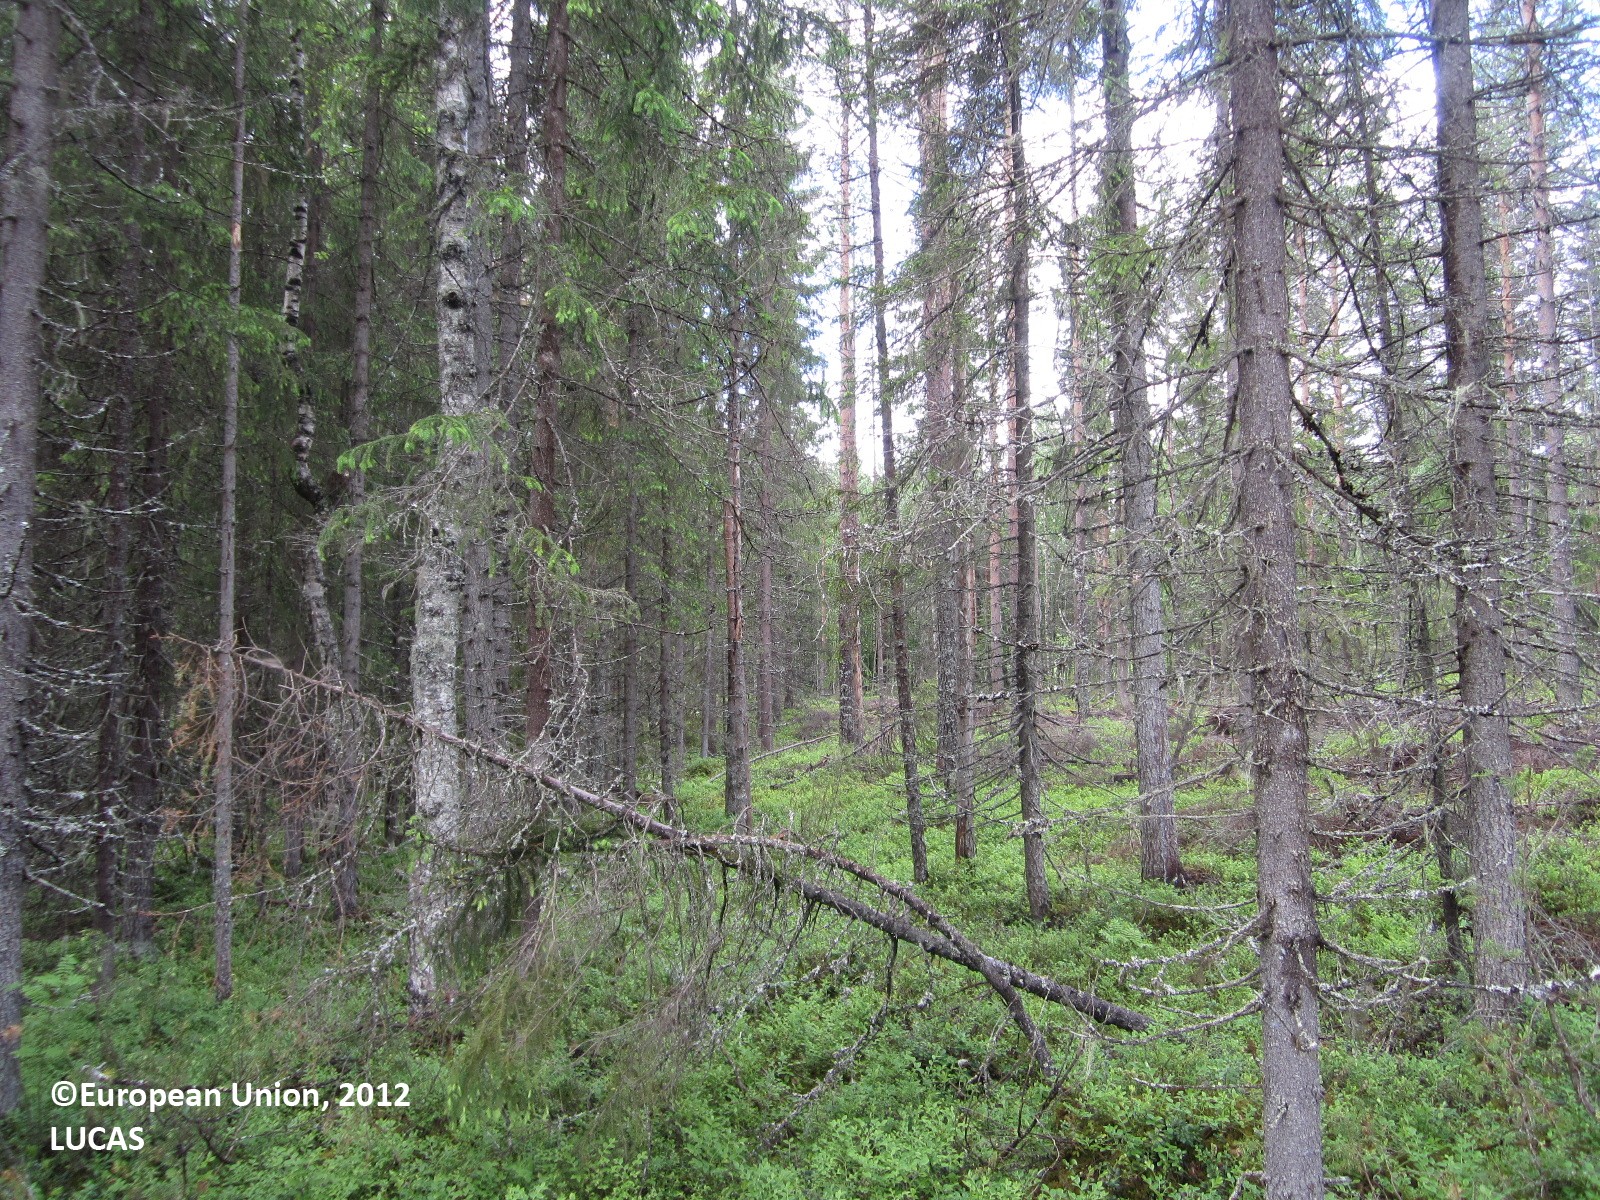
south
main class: Woodland
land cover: Spruce dominated coniferous woodland
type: boreal forest
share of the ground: > 75 %
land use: Forestry
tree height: > 5 m
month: June
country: FI
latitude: 64.4603
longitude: 29.6574
